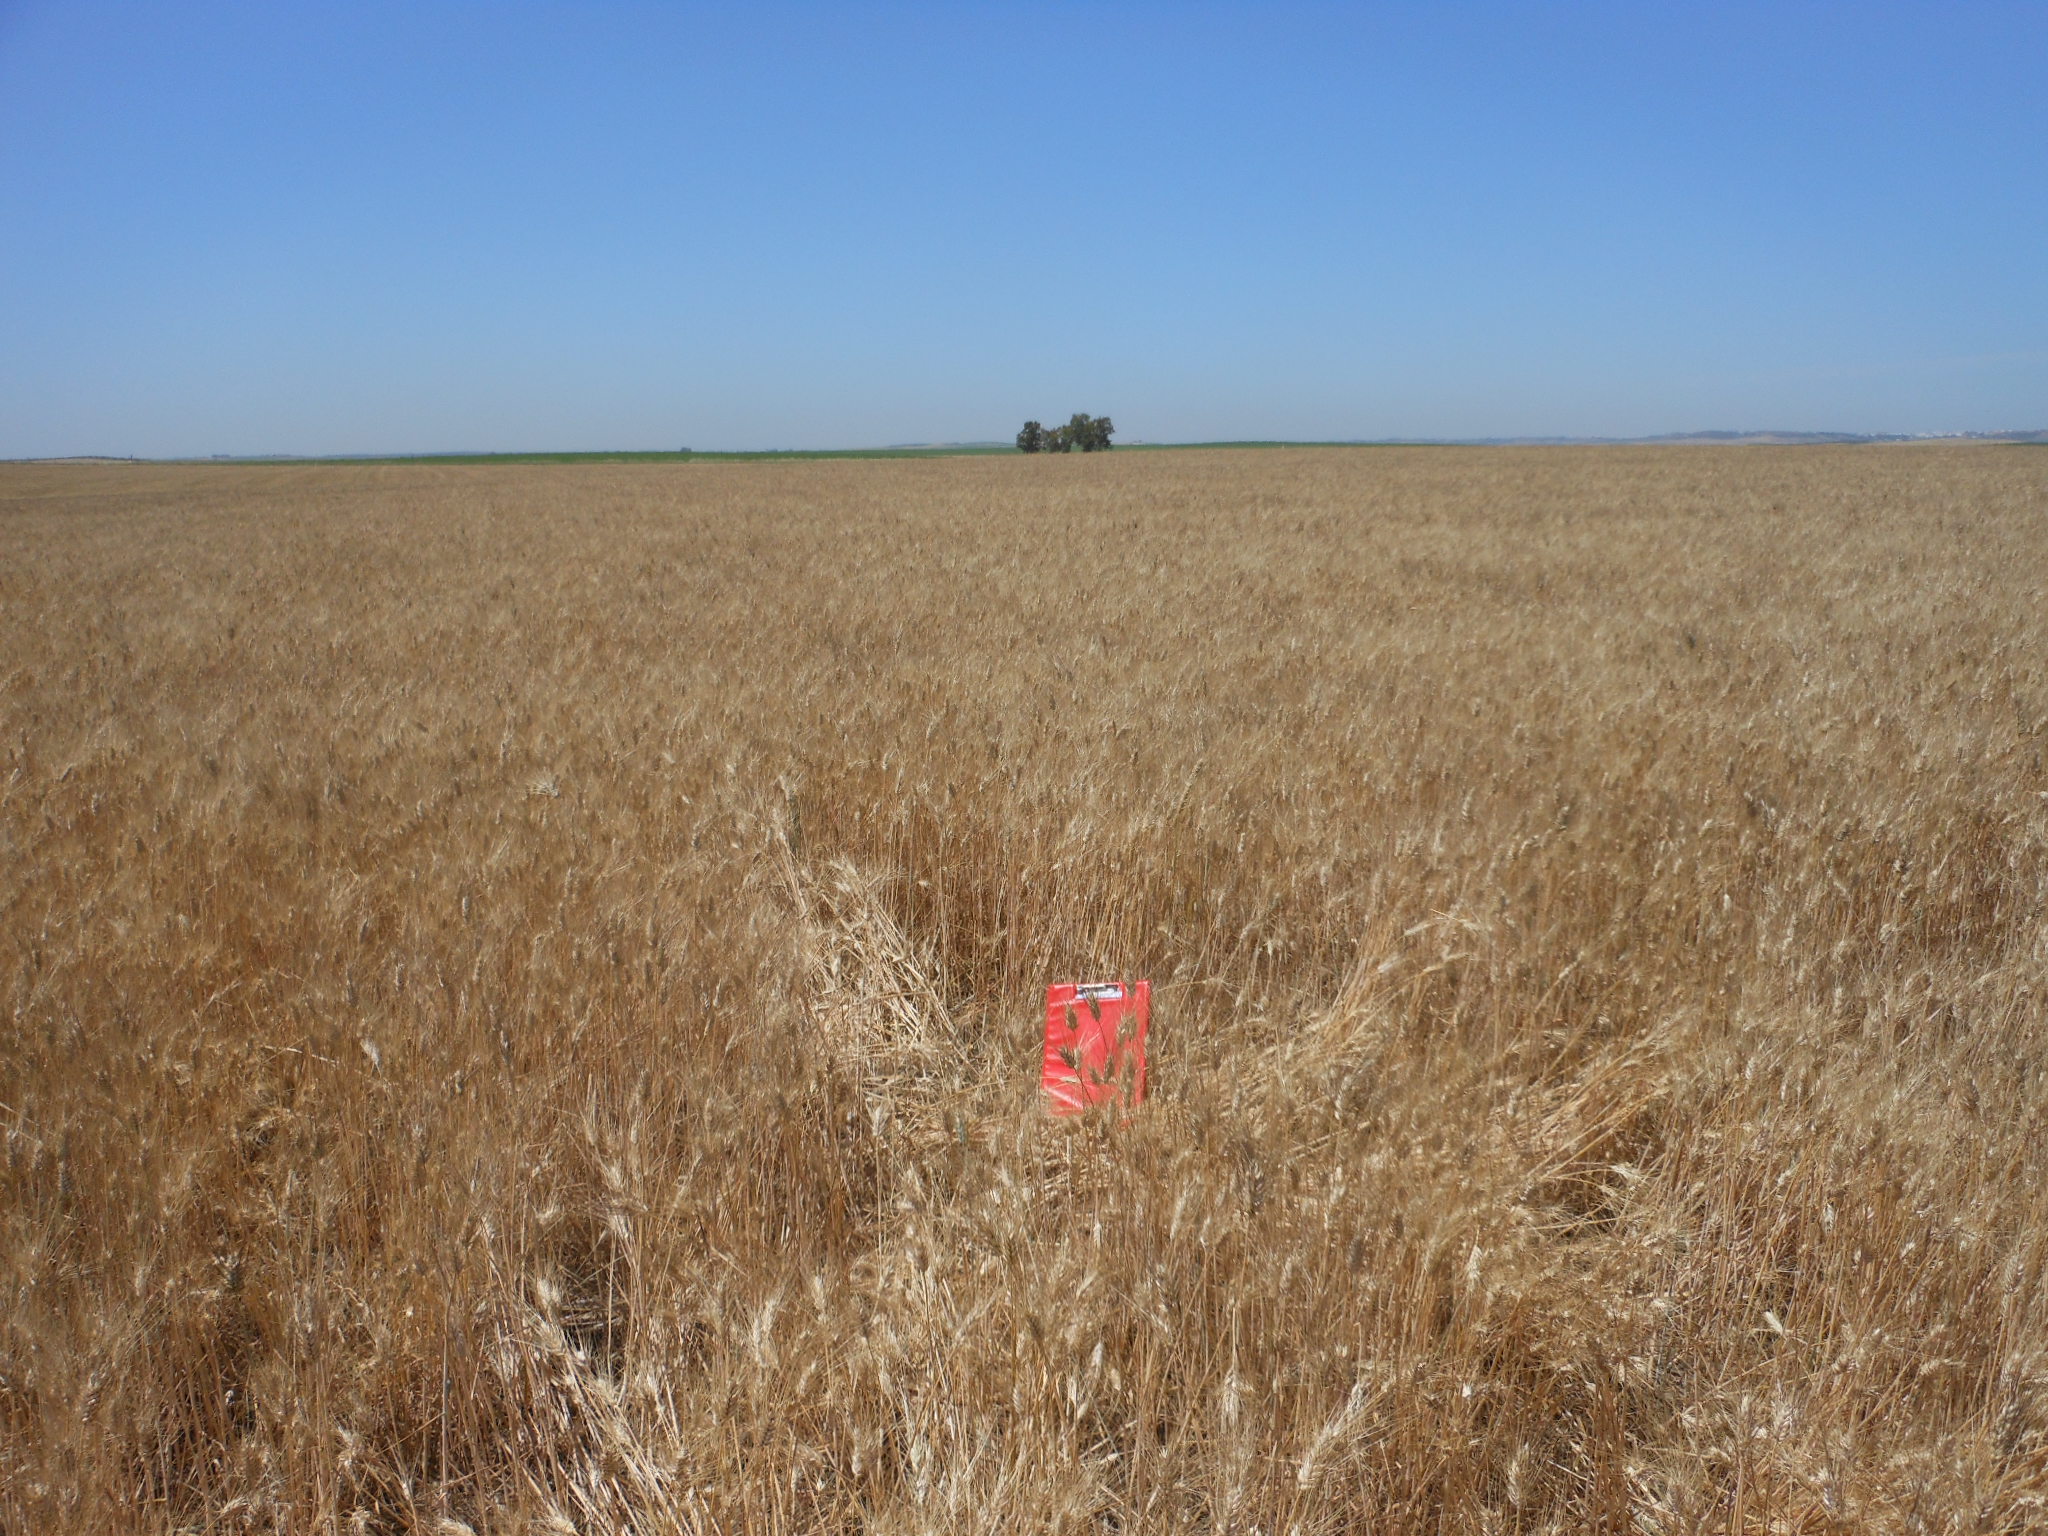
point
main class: Cropland
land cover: Durum wheat
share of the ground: > 75 %
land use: Agriculture (excluding fallow land and kitchen gardens)
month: May
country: ES
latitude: 37.3745
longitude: -5.5896
